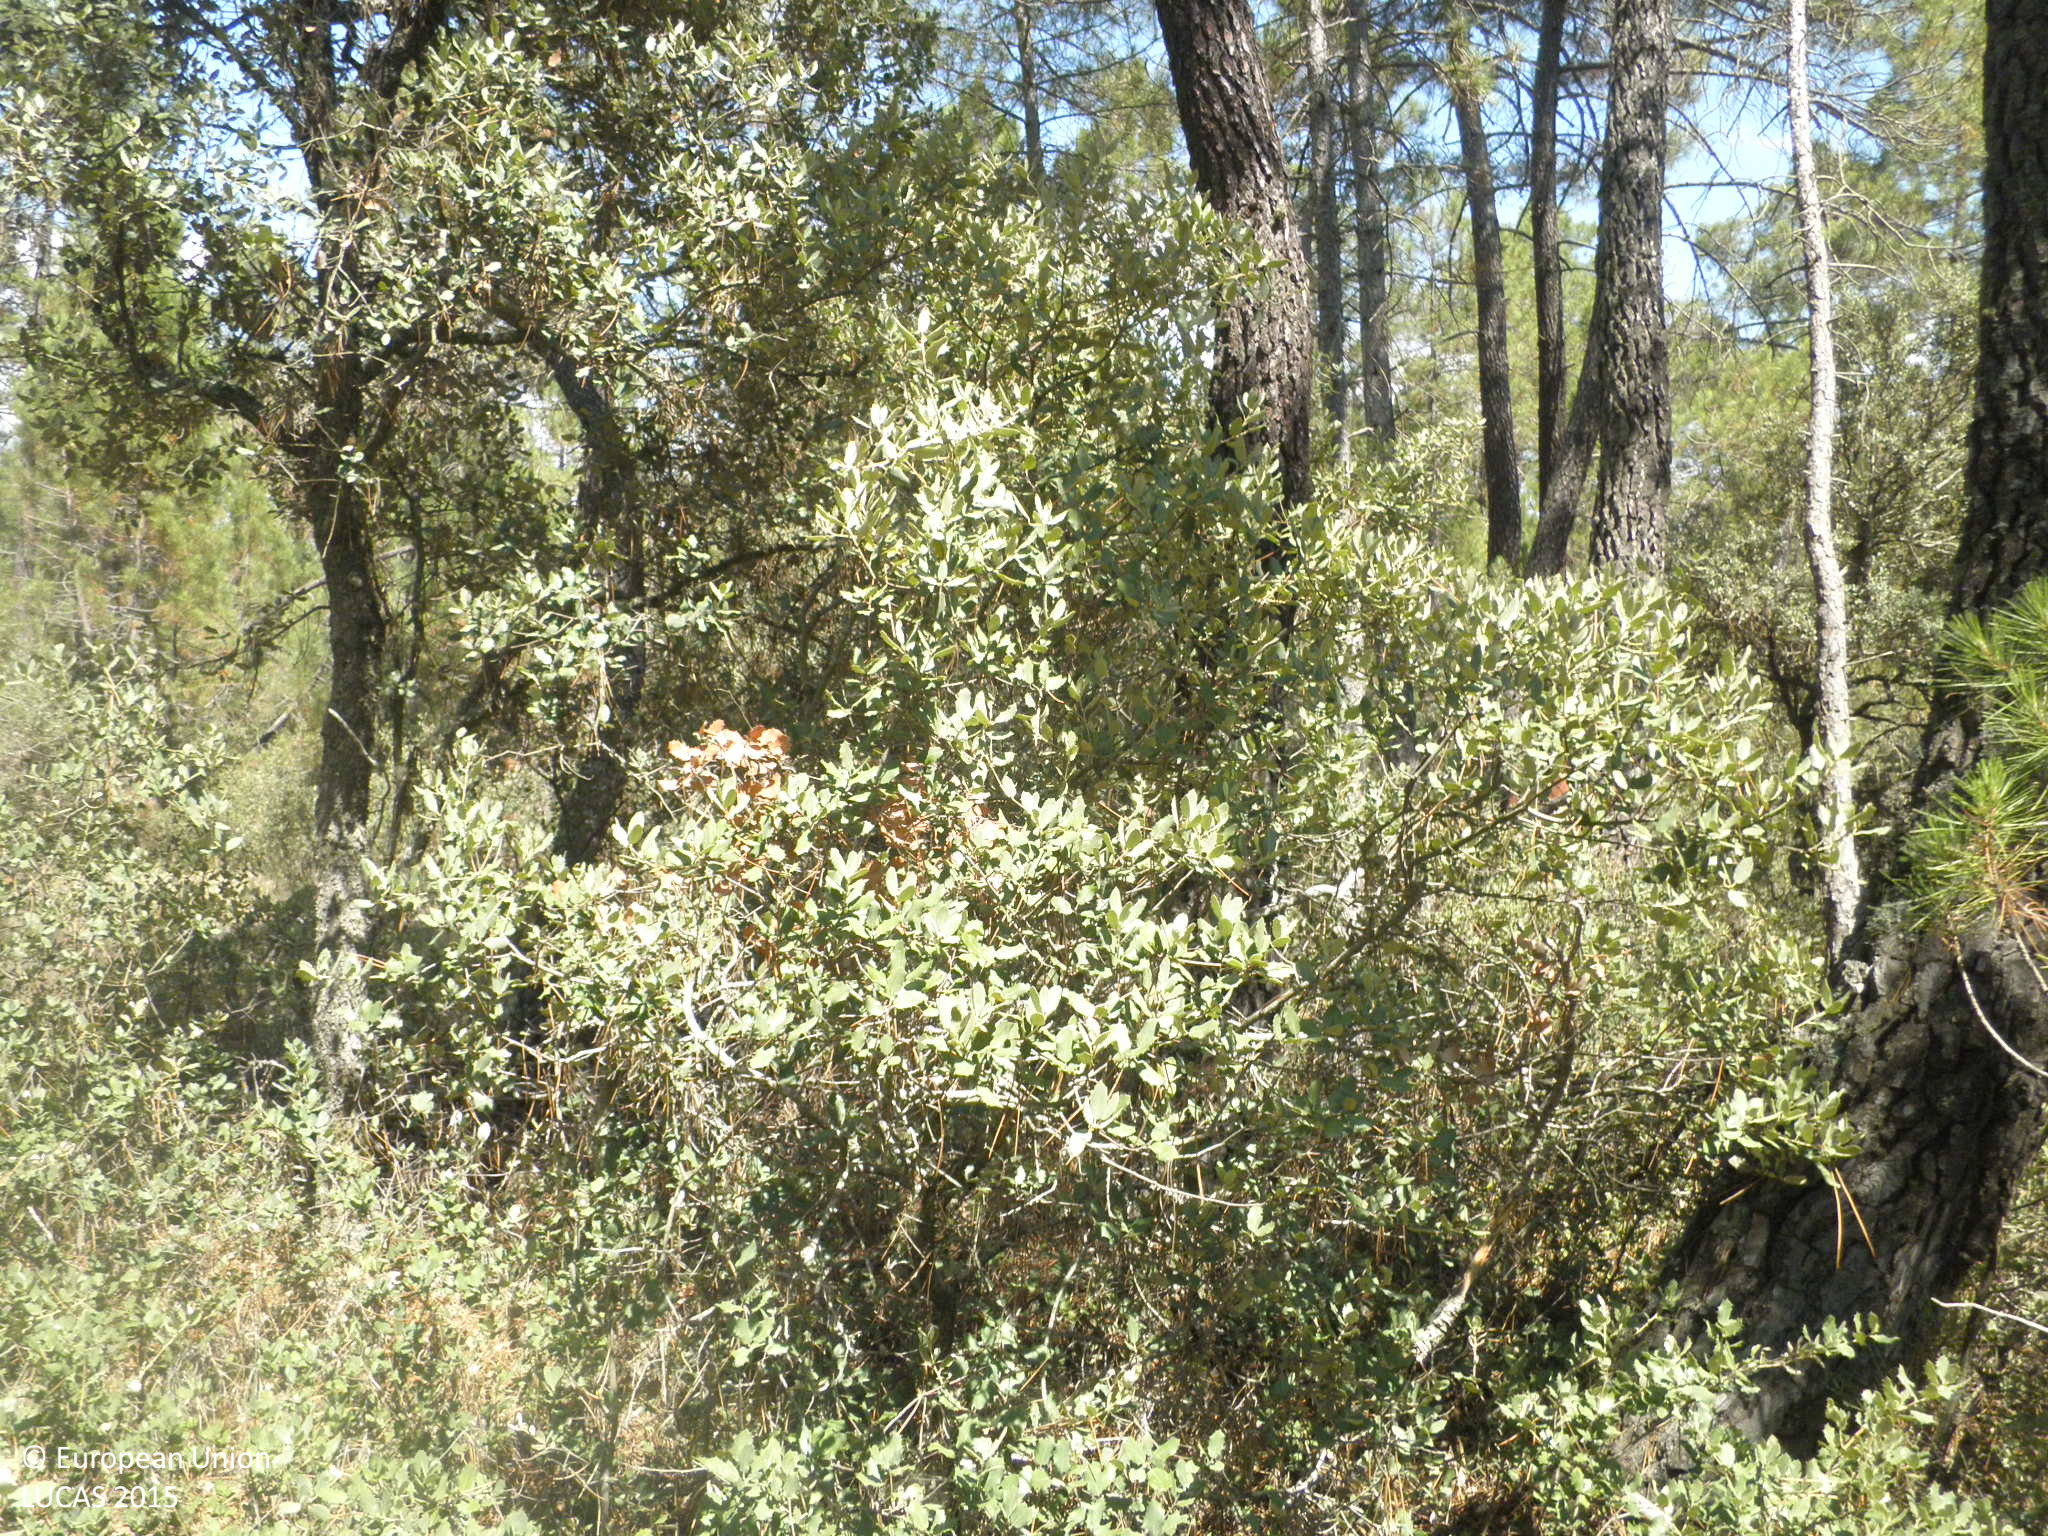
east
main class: Woodland
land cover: Pine dominated mixed woodland
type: coniferous forest of the mediterranean region
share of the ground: 50 - 75 %
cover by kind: coniferous forest trees 35 %, broadleaved forest trees 25 %, unconsolidated bare surface 20 %, herbaceous plants 15 %, shrubs 5 %
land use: Forestry
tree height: > 5 m
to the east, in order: Pine dominated mixed woodland
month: July
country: ES
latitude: 39.6754
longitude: -1.8418
